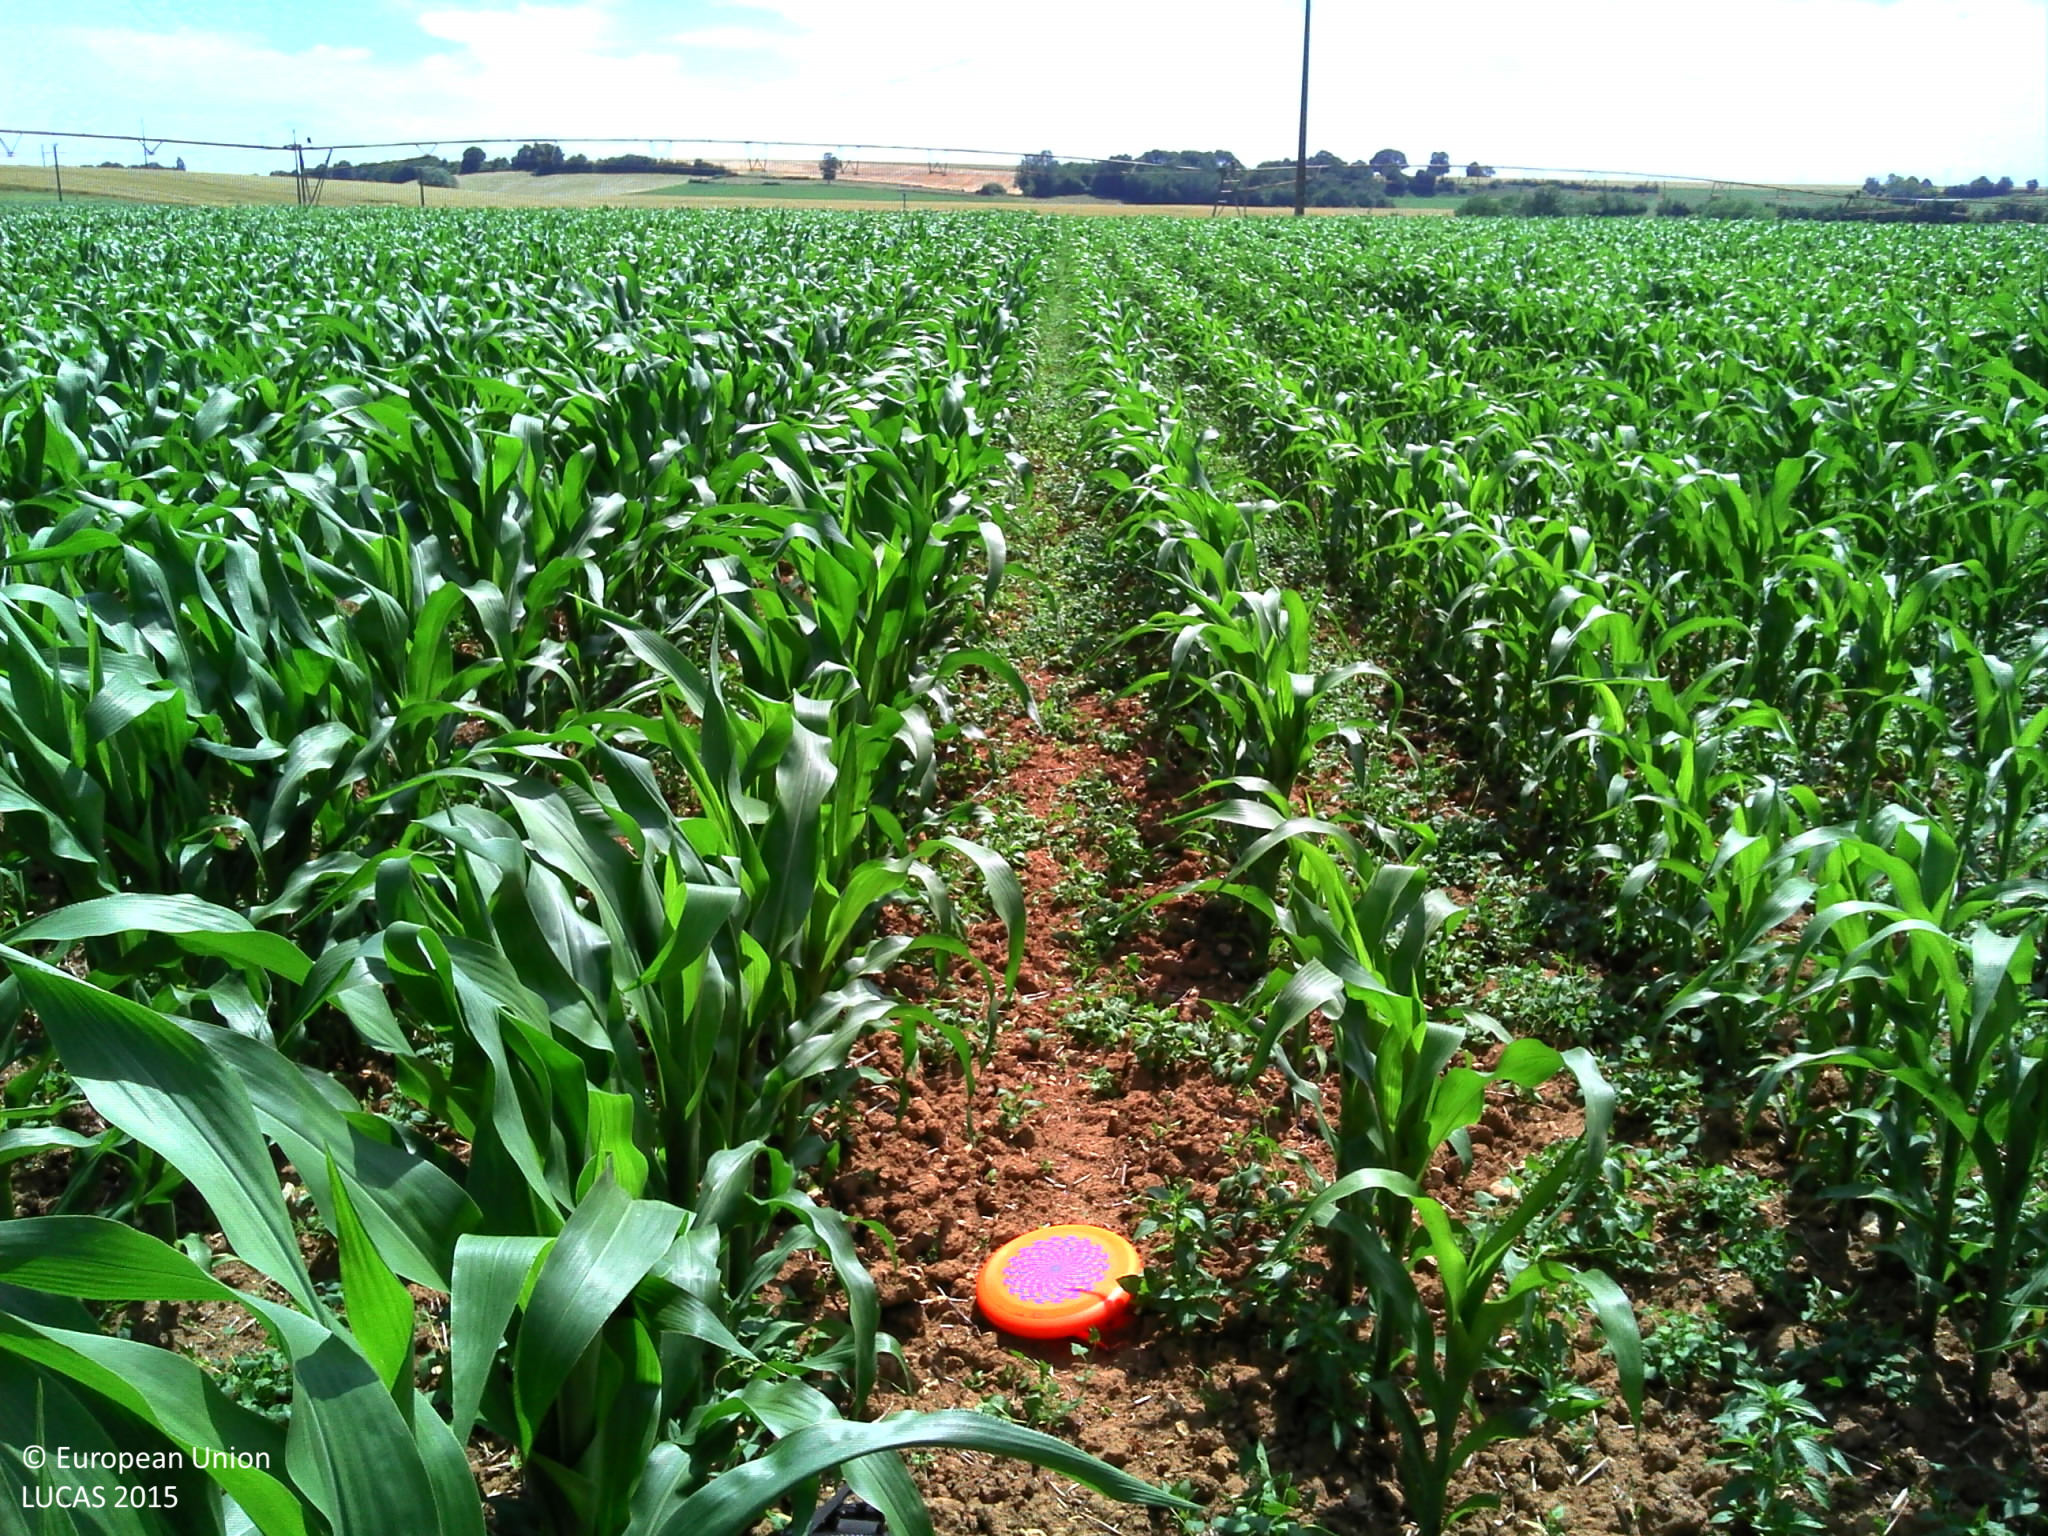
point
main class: Cropland
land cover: Maize
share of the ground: > 75 %
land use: Agriculture (excluding fallow land and kitchen gardens)
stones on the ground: 10 - 25 %
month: June
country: FR
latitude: 48.3160
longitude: 0.2507
